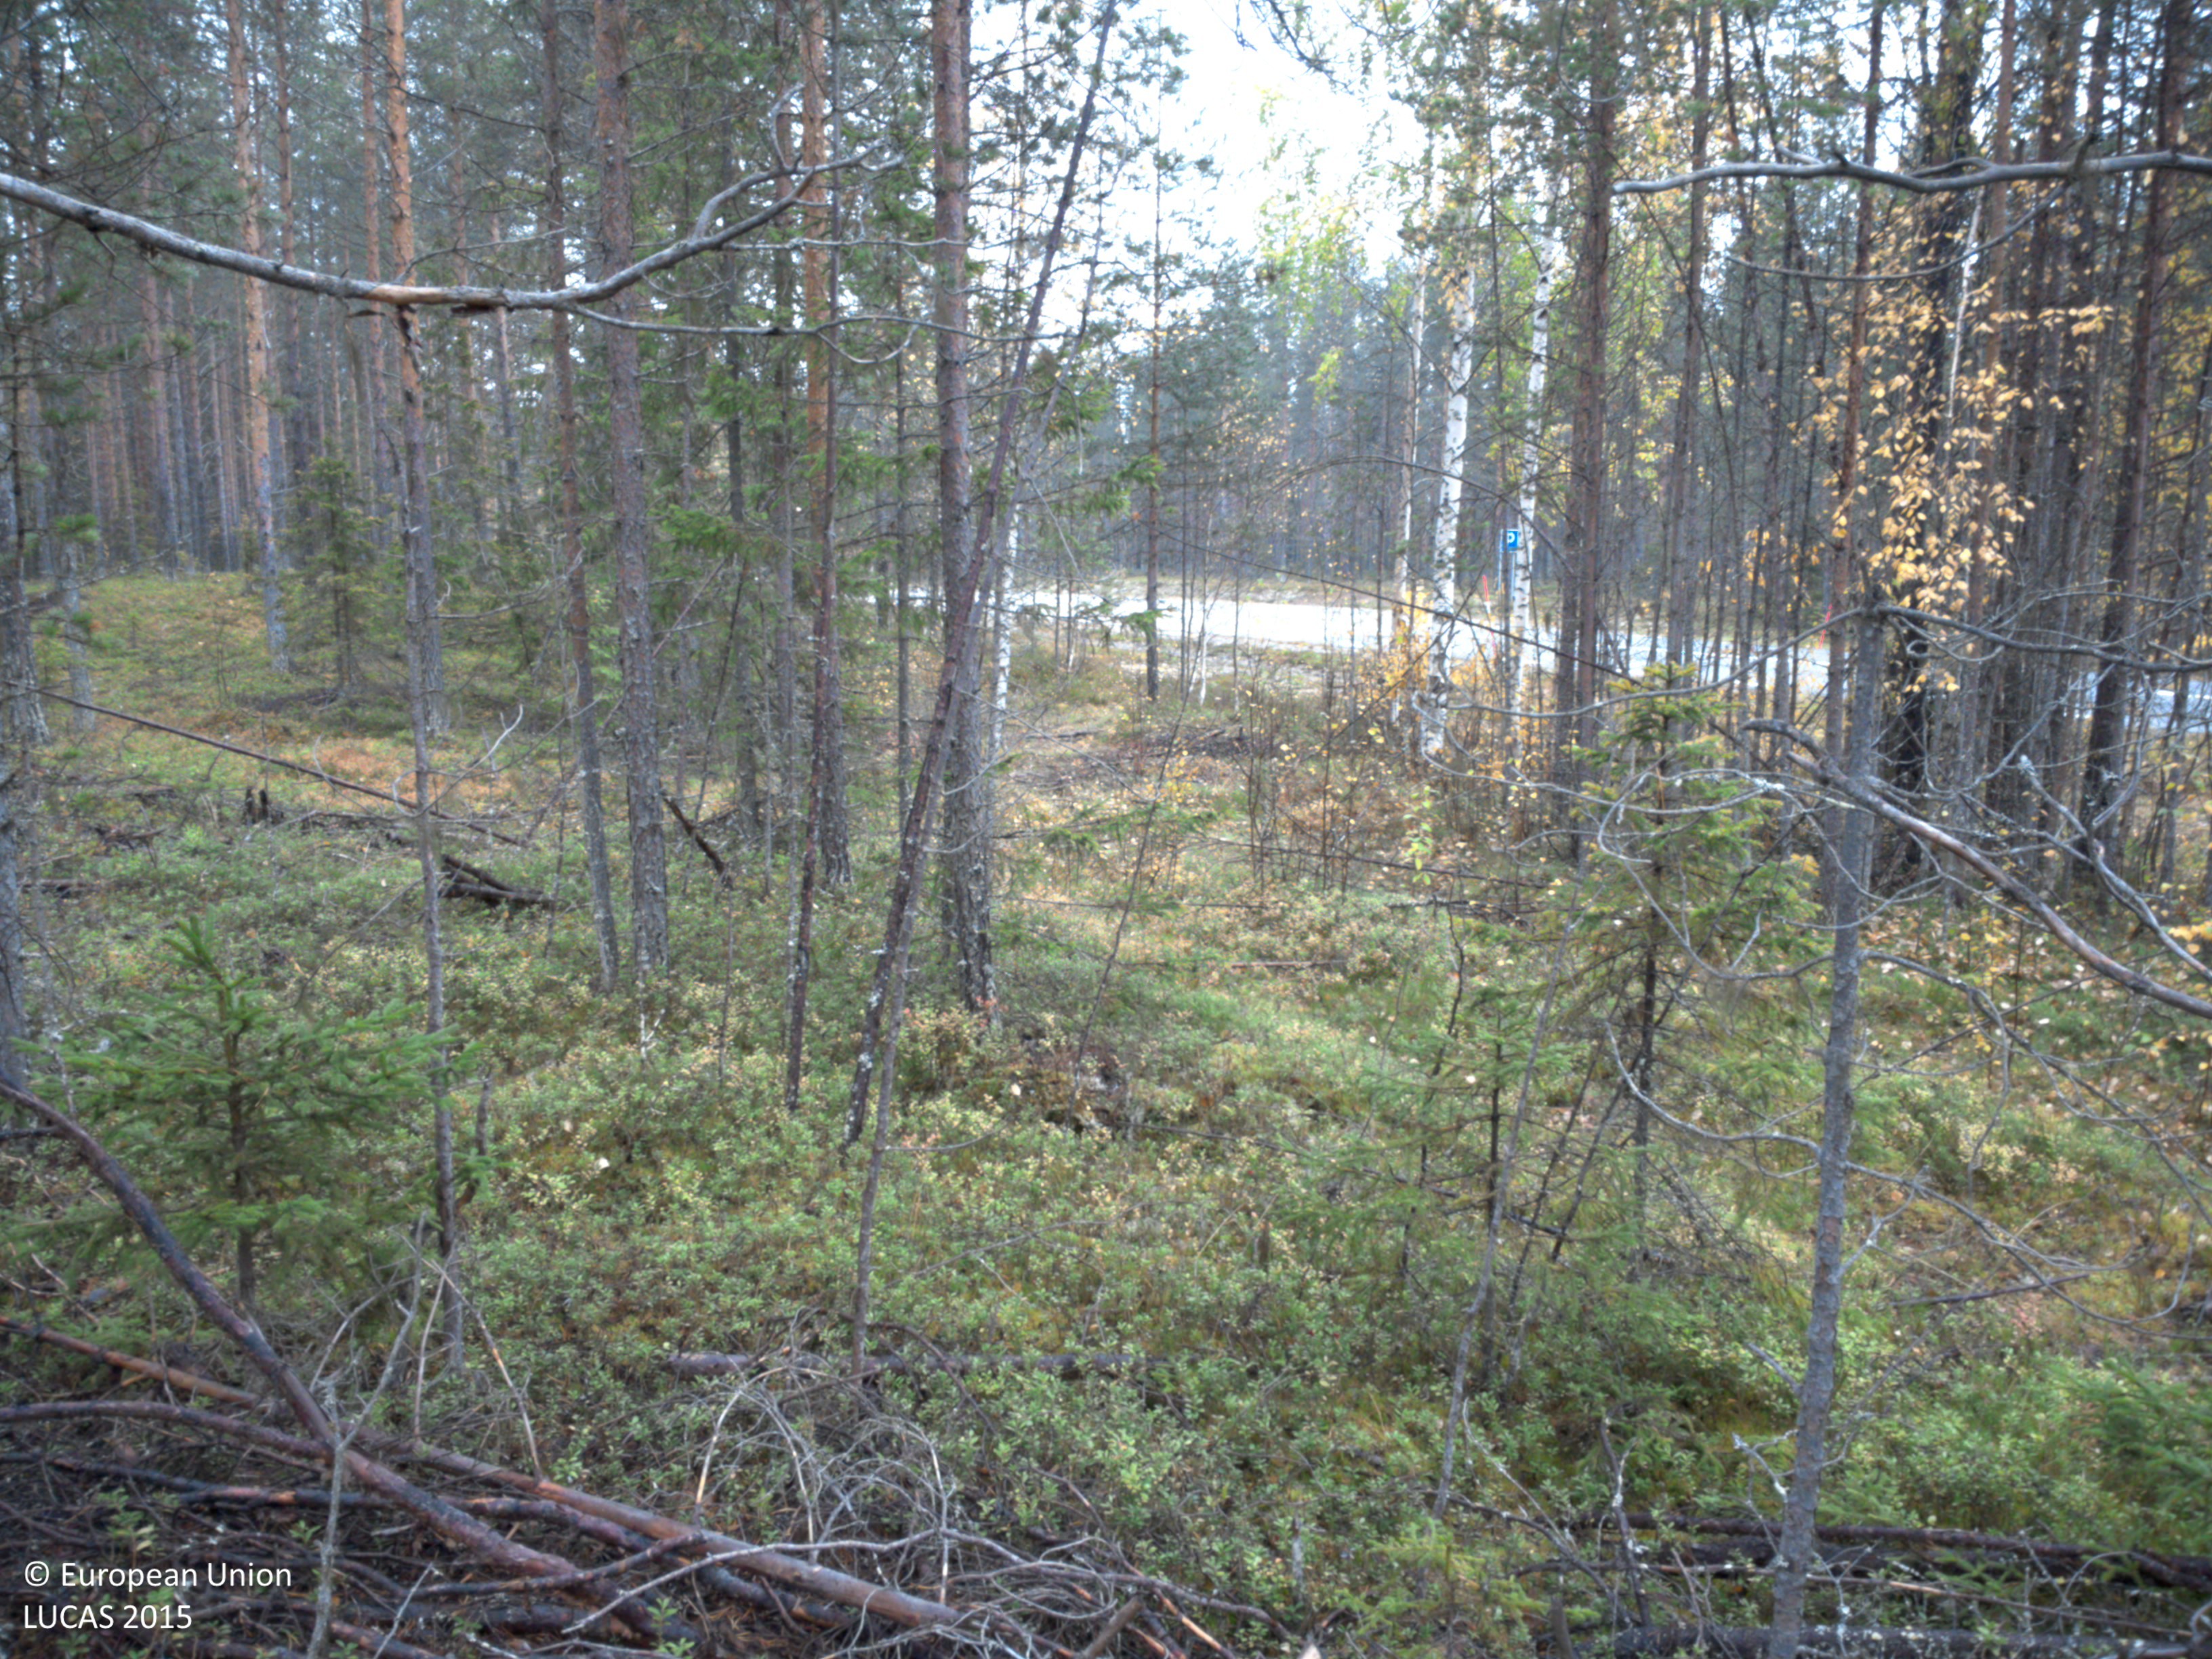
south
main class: Woodland
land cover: Pine dominated coniferous woodland
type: boreal forest
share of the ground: 50 - 75 %
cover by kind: coniferous forest trees 55 %, shrubs 35 %, lichens and mosses 10 %
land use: Forestry
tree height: > 5 m
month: September
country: SE
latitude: 64.8000
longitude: 18.9551
